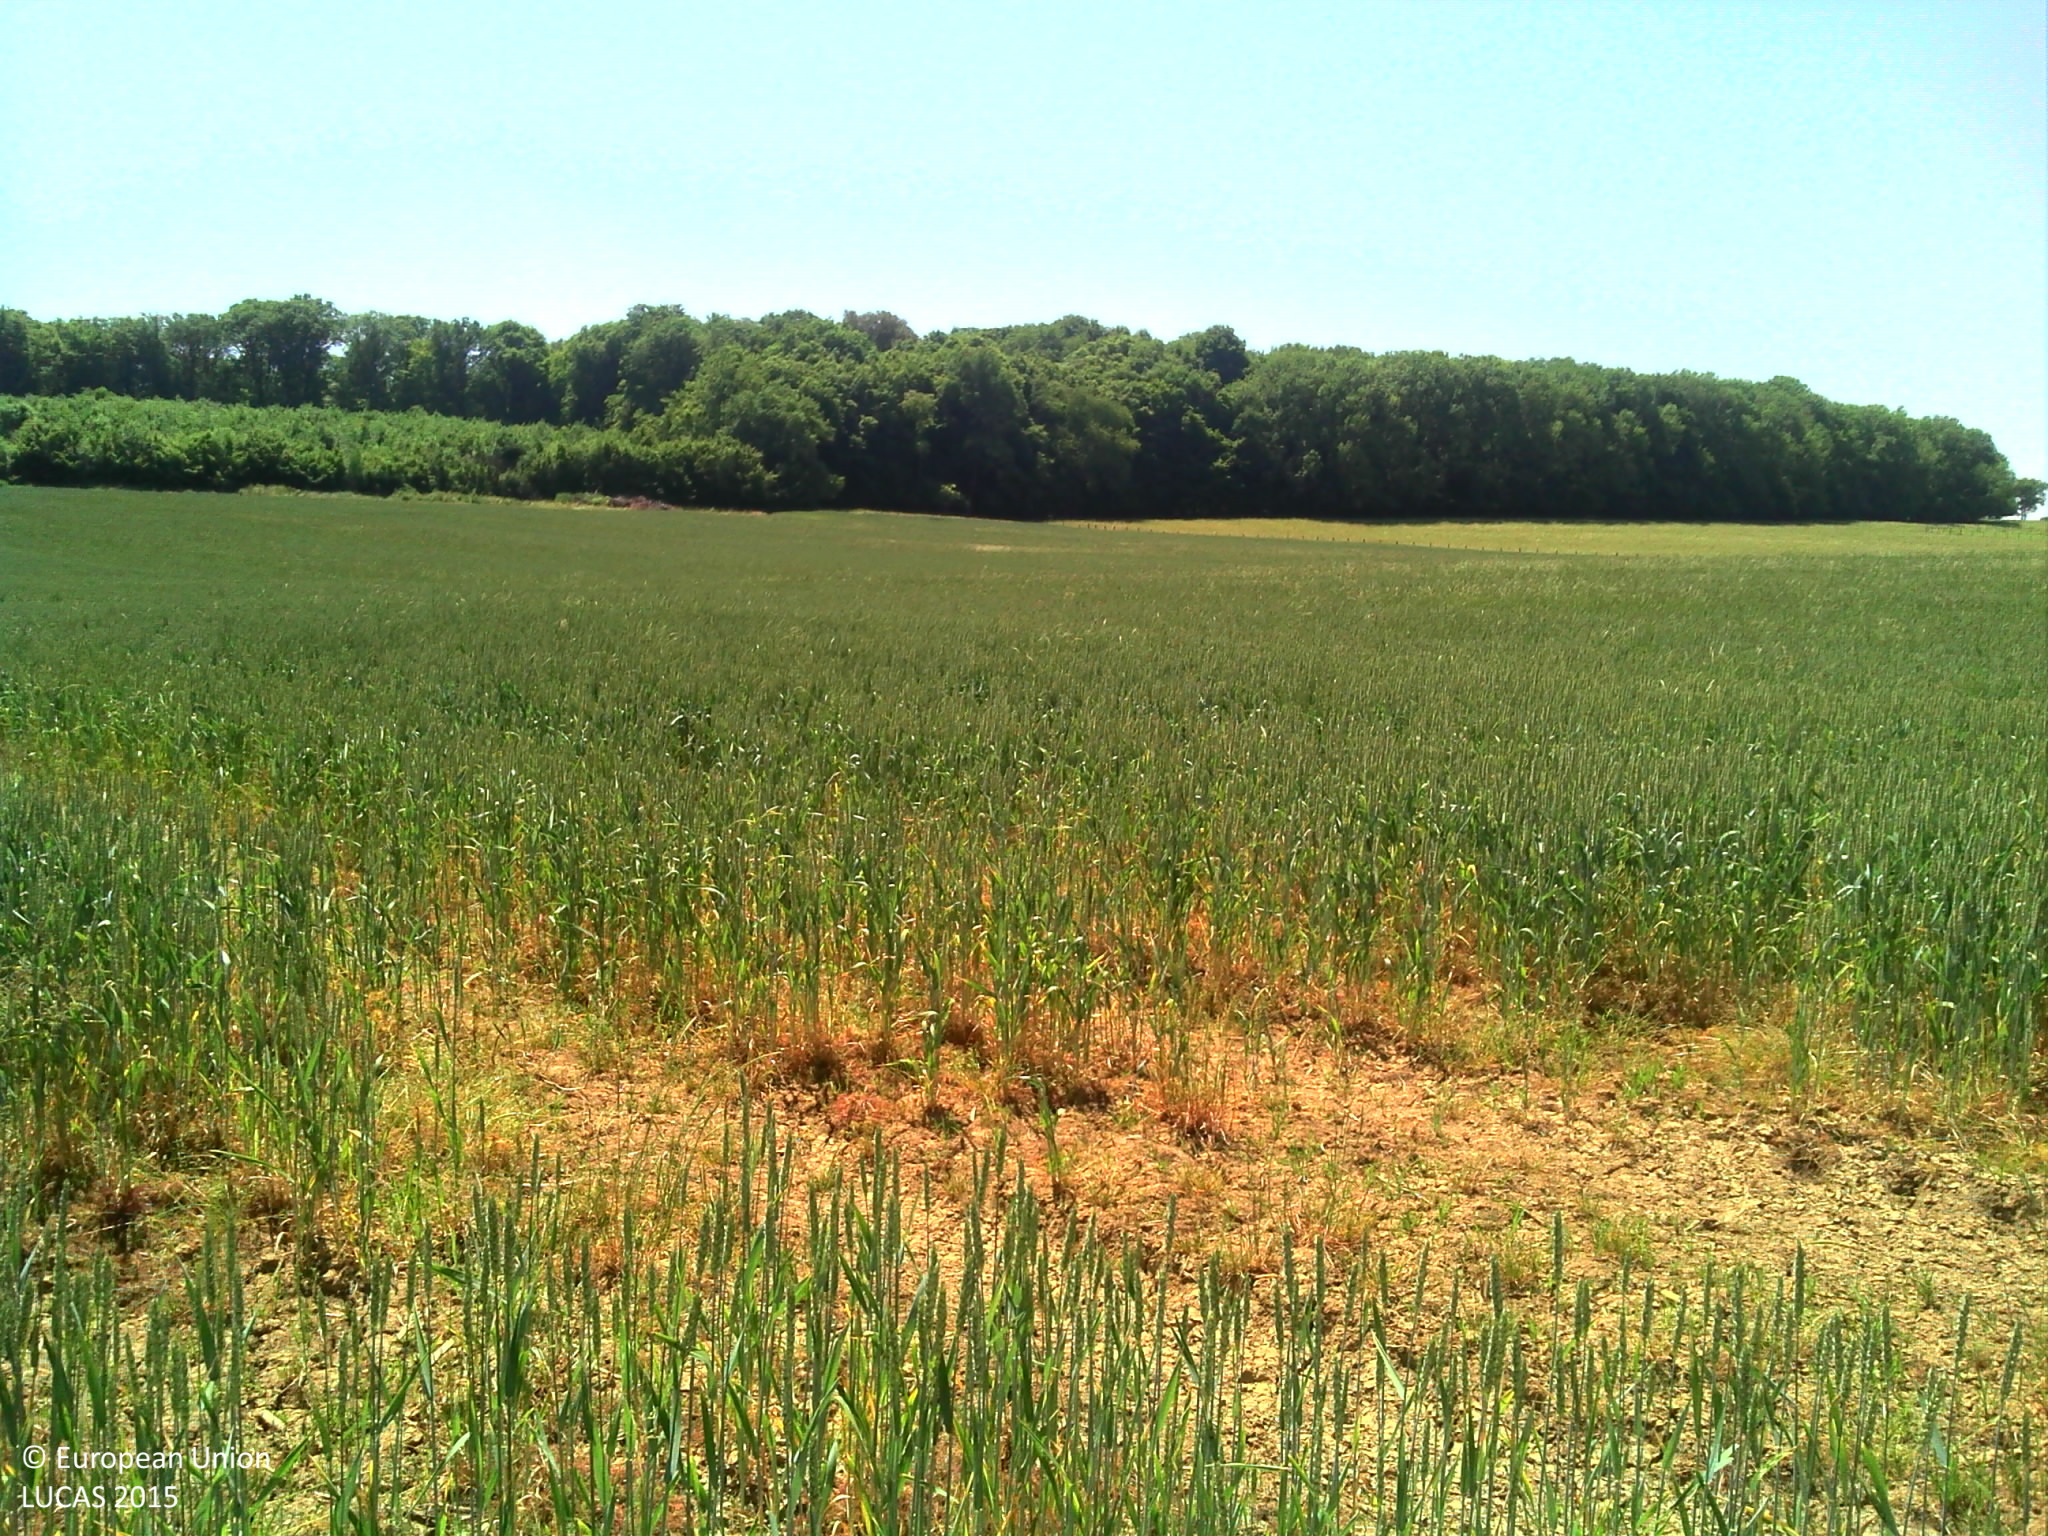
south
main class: Cropland
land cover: Common wheat
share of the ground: > 75 %
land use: Agriculture (excluding fallow land and kitchen gardens)
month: June
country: FR
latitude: 47.6690
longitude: 6.1257
